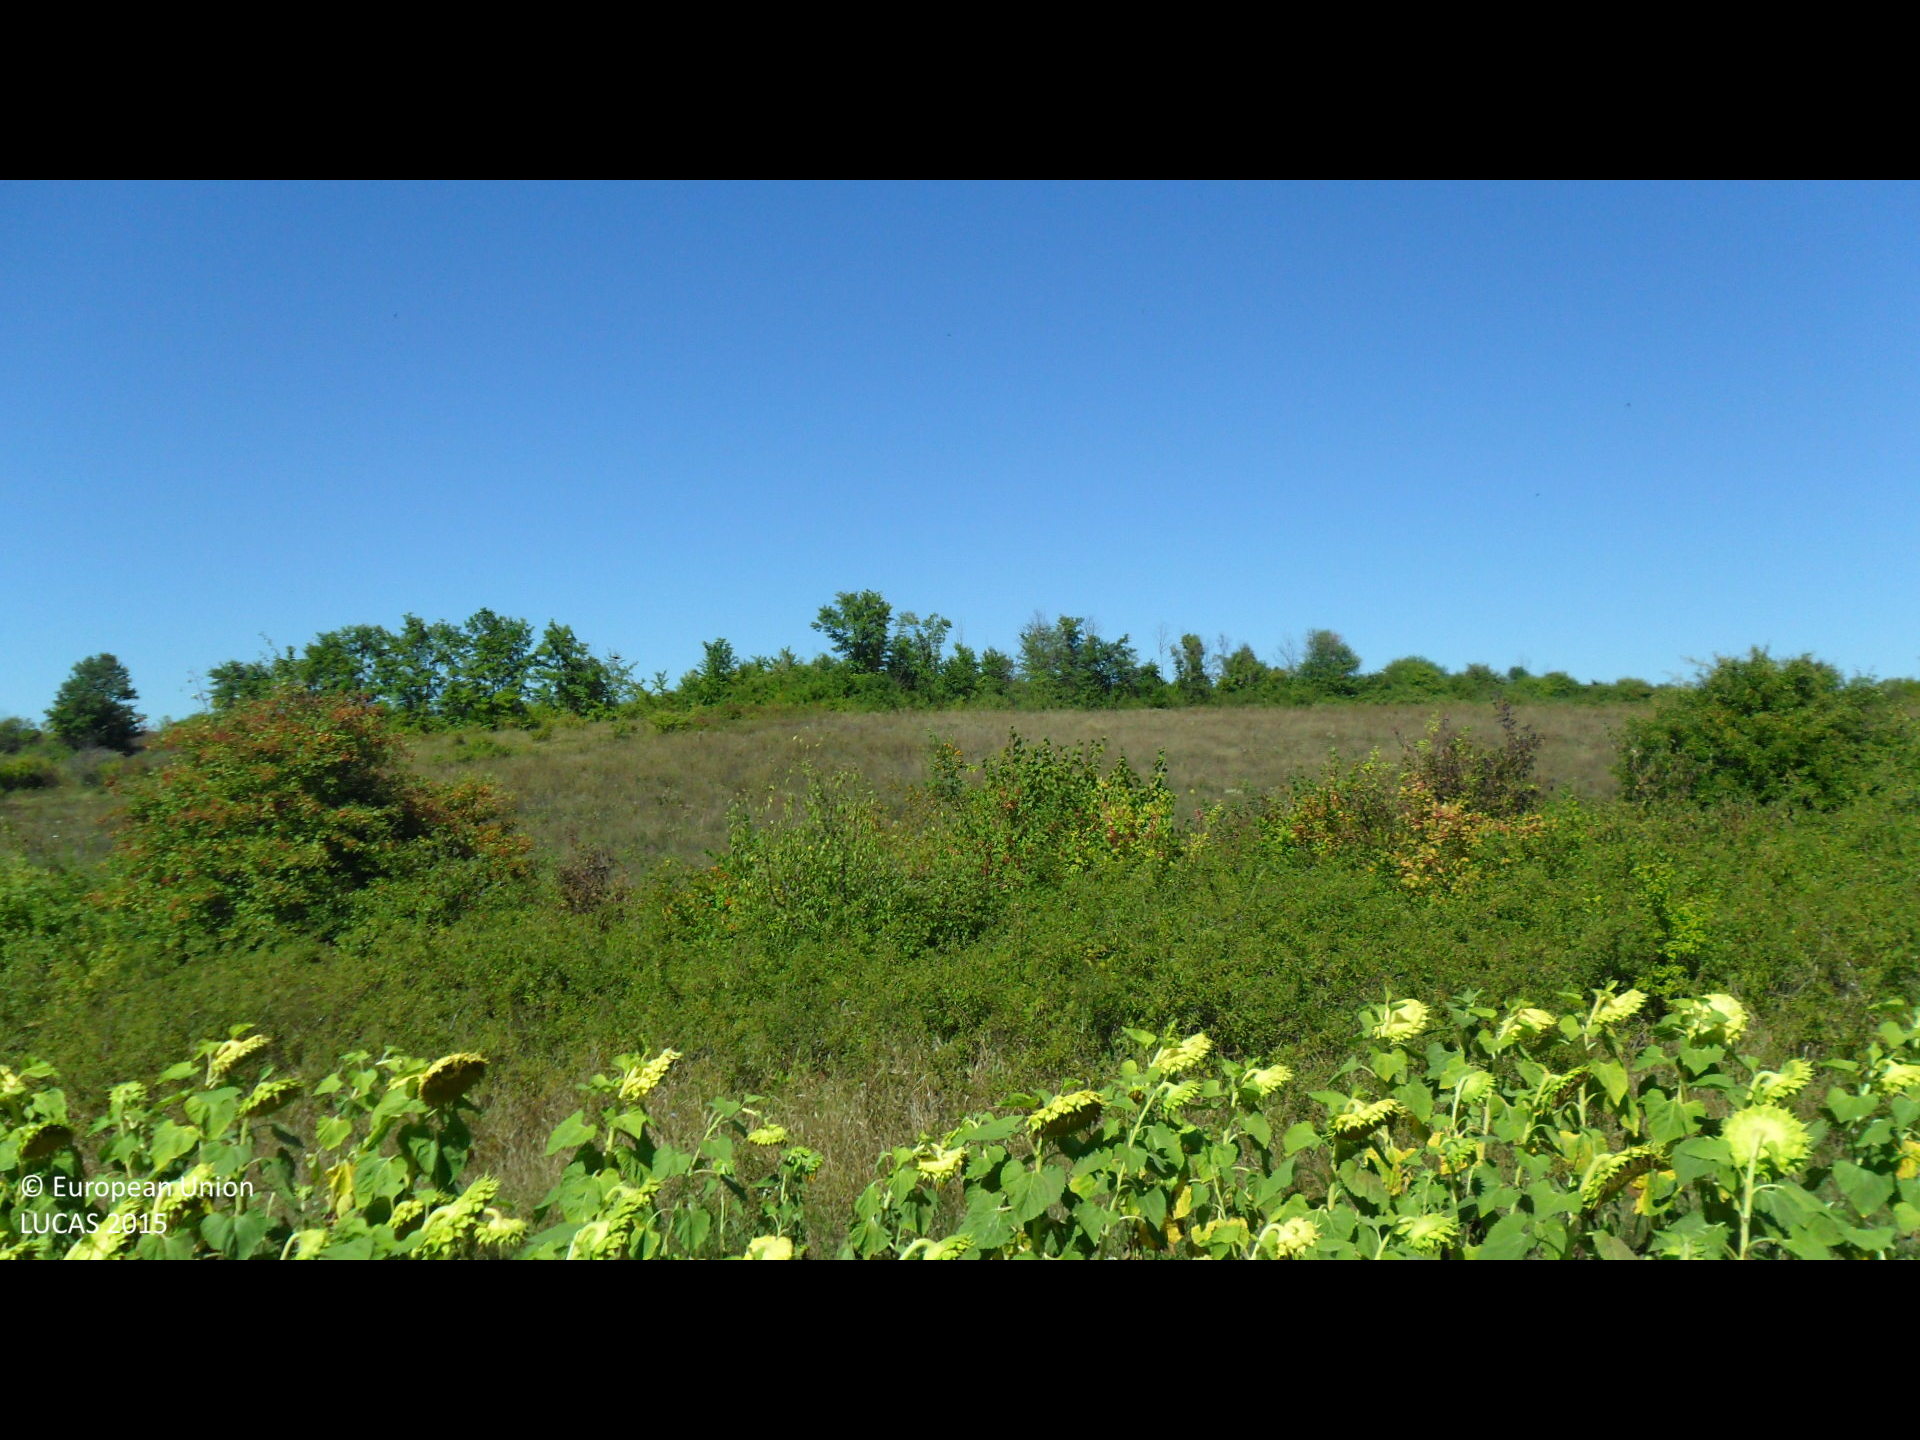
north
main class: Cropland
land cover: Sunflower
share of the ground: > 75 %
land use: Agriculture (excluding fallow land and kitchen gardens)
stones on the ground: < 10 %
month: September
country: BG
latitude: 43.1214
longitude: 26.4332
